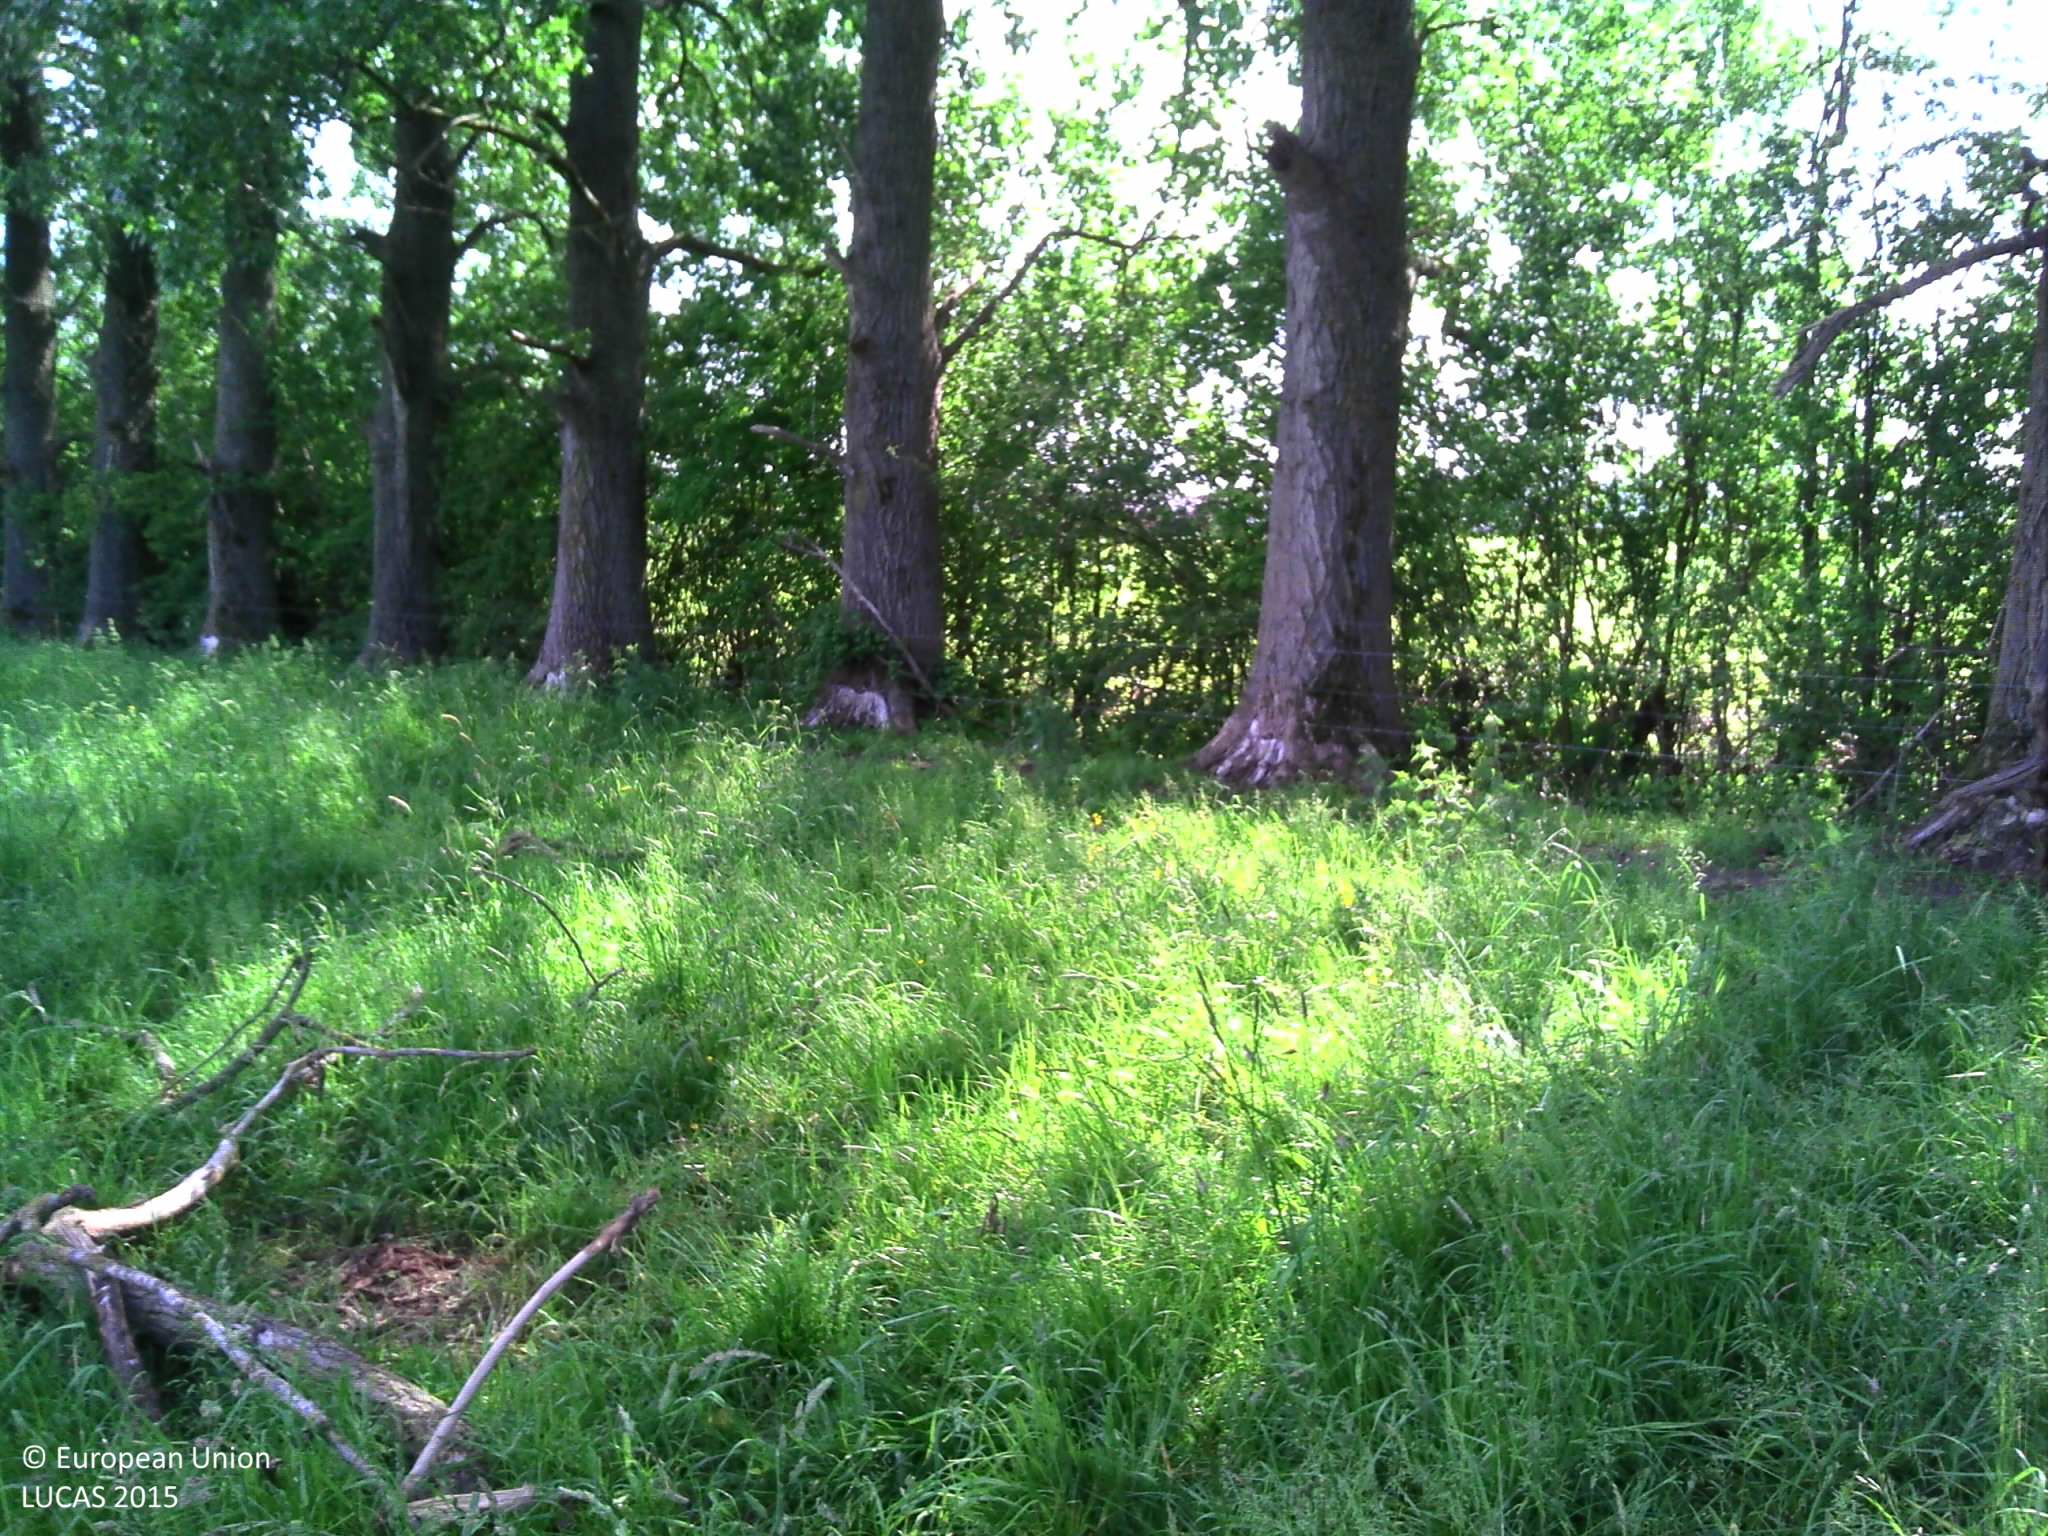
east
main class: Grassland
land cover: Grassland without tree/shrub cover
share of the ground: > 75 %
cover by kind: herbaceous plants 100 %
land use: Agriculture (excluding fallow land and kitchen gardens)
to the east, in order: Grassland without tree/shrub cover; Fences; Lines of trees; Ditches and canals; Maize; Potatoes; Maize; Electric lines; Grass margins; Paved roads, cycling and walking lanes; Grass margins; Common wheat
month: June
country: BE
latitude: 50.9236
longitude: 3.9192
